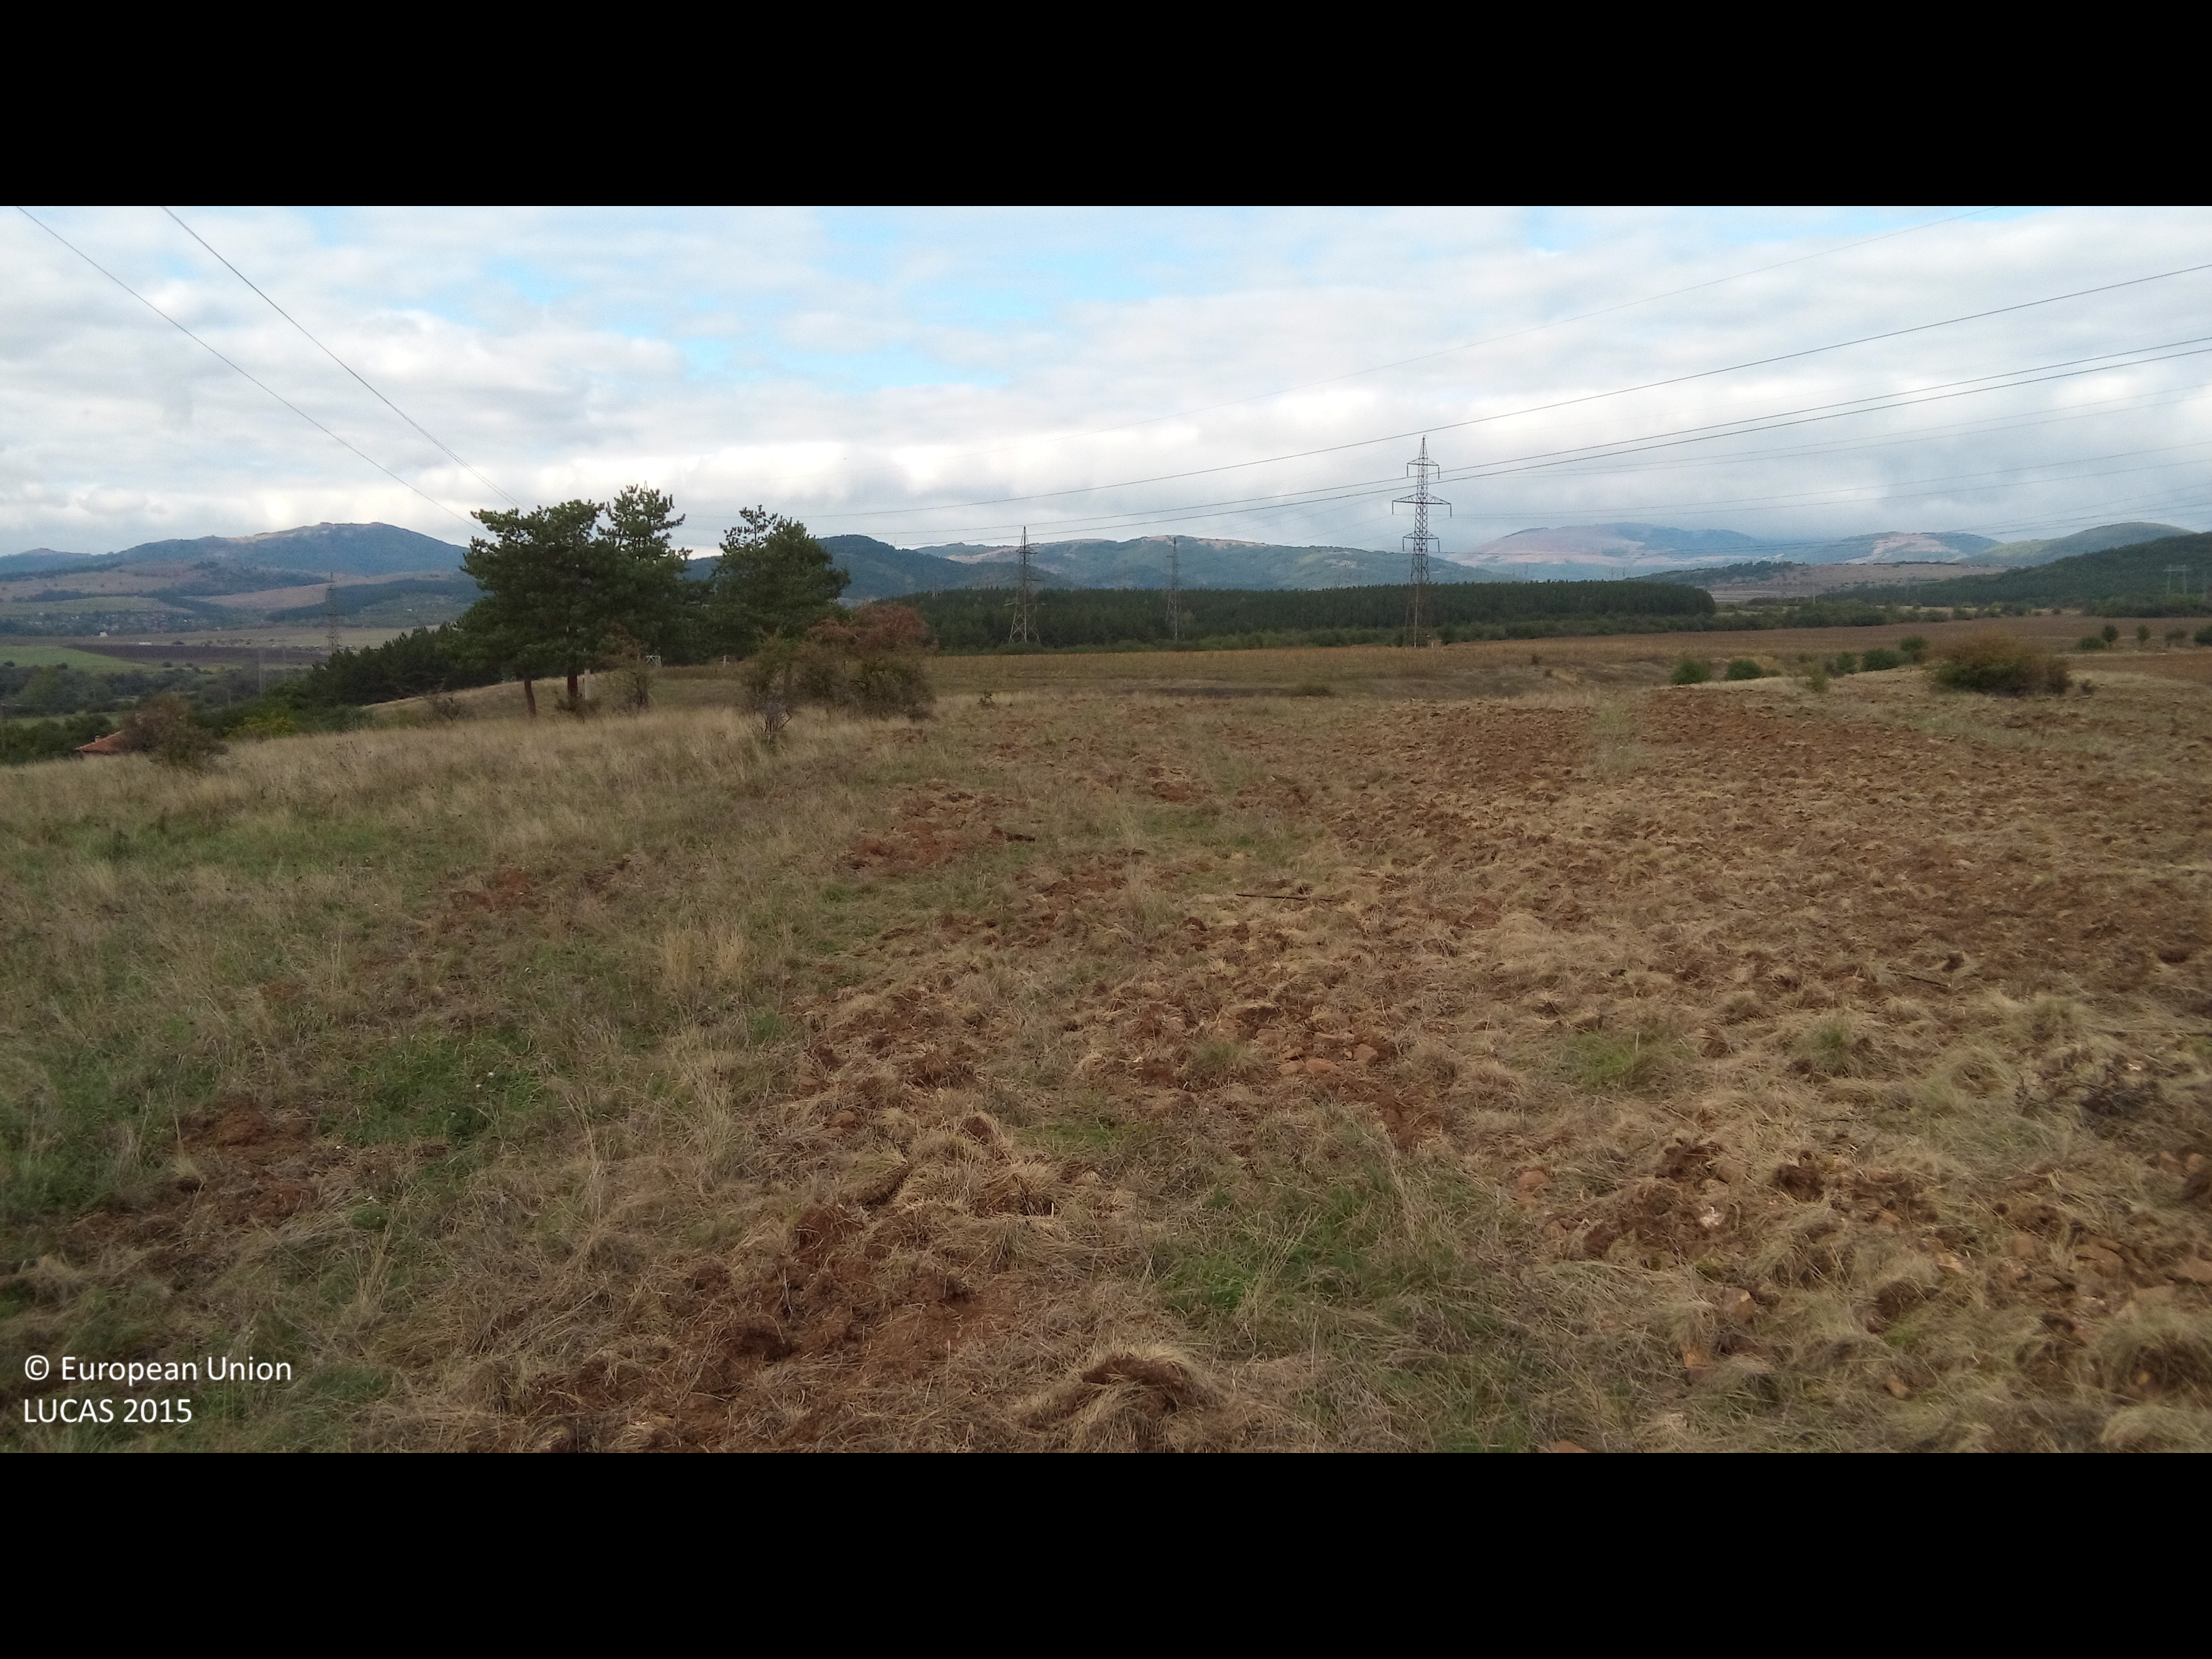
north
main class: Grassland
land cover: Grassland with sparse tree/shrub cover
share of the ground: 50 - 75 %
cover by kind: herbaceous plants 65 %, unconsolidated bare surface 30 %, broadleaved forest trees 5 %
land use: Agriculture (excluding fallow land and kitchen gardens)
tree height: > 5 m
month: October
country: BG
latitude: 42.7154
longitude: 23.6293
